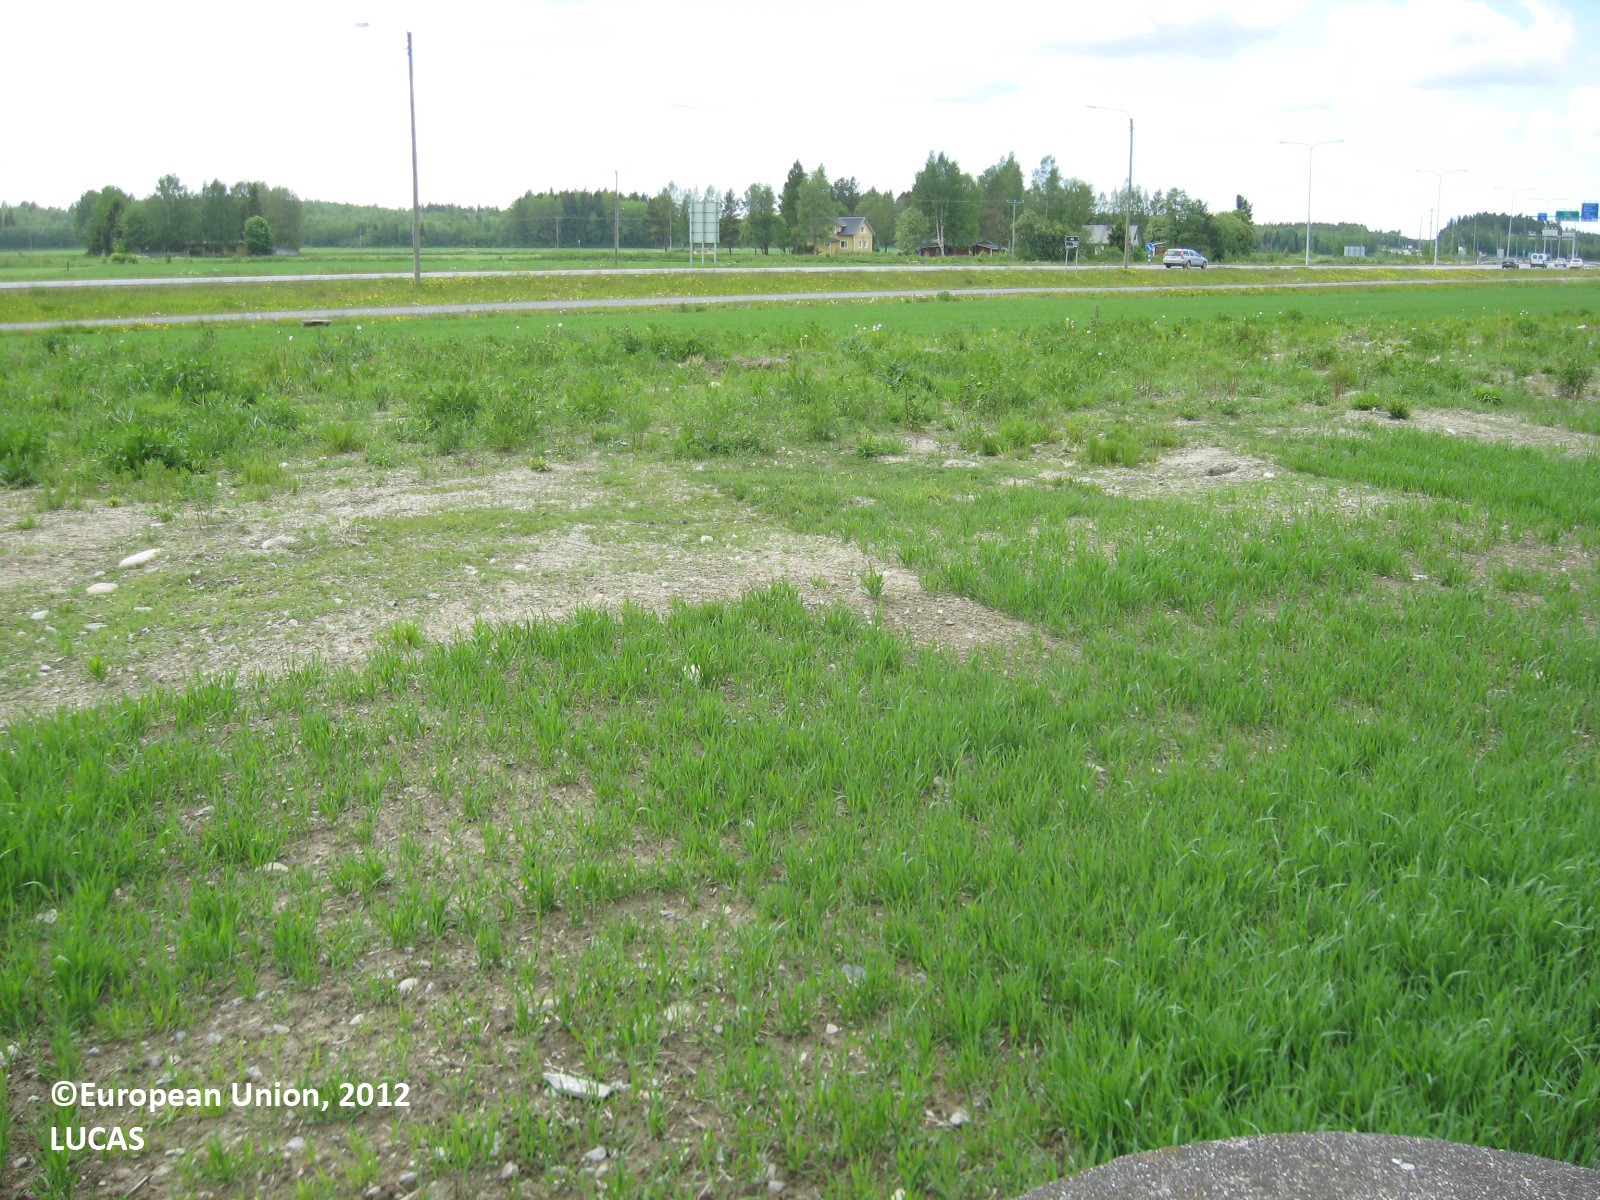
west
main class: Cropland
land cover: Oats
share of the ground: > 75 %
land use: Agriculture (excluding fallow land and kitchen gardens)
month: June
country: FI
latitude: 63.0238
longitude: 21.7997
